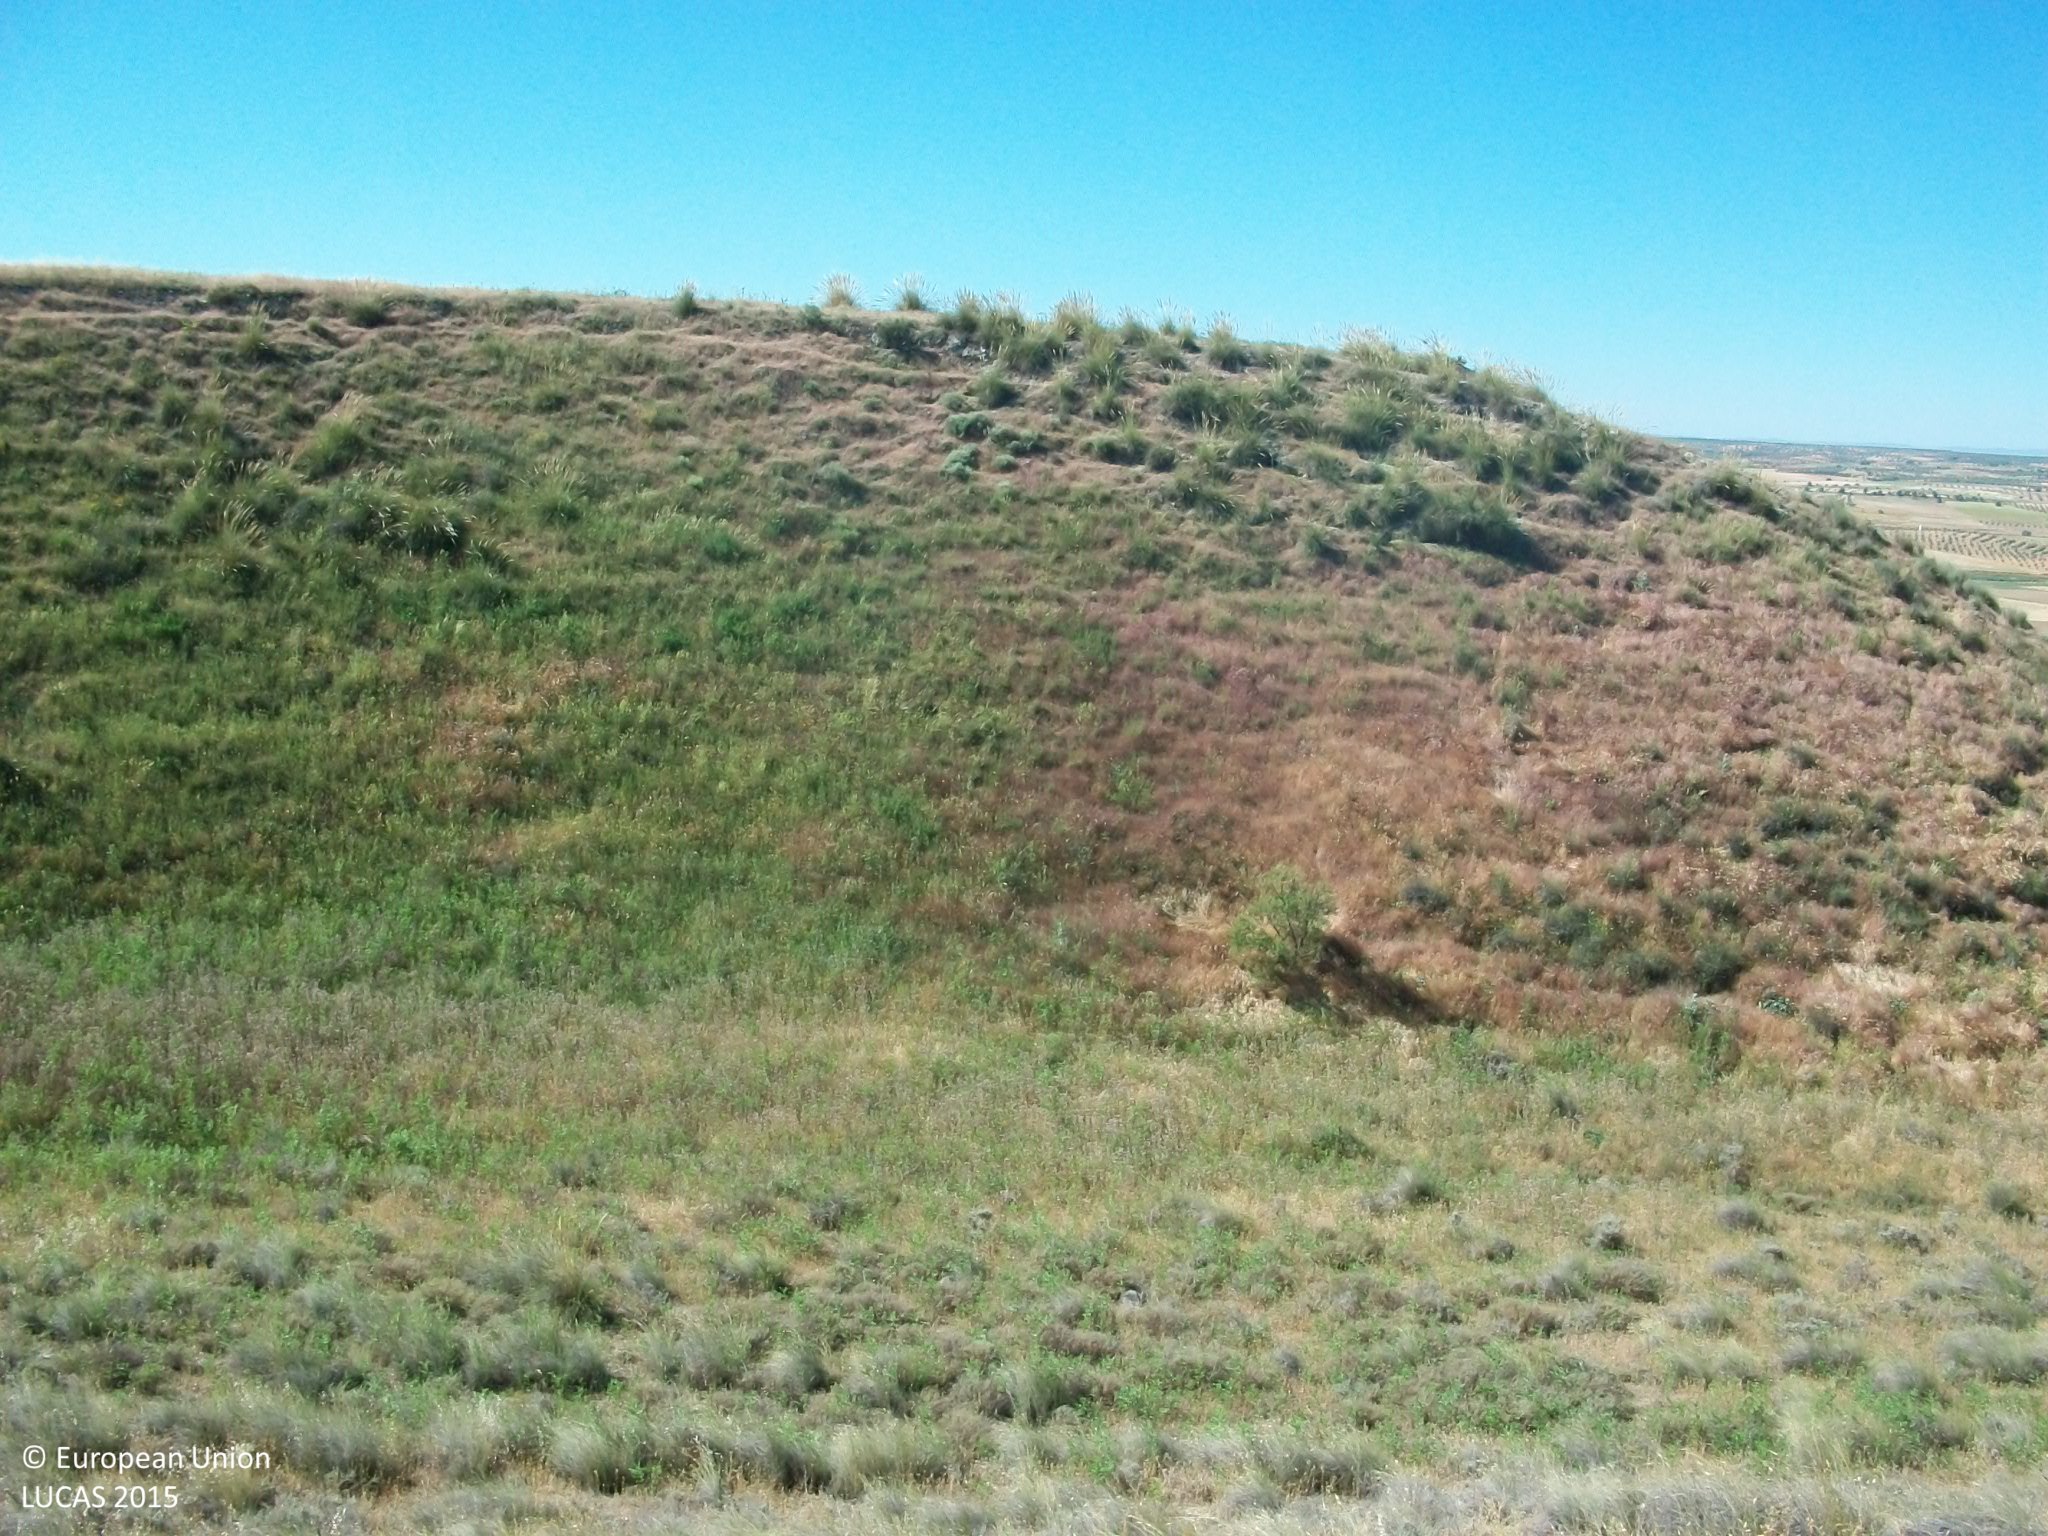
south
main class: Grassland
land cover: Grassland without tree/shrub cover
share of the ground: > 75 %
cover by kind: herbaceous plants 80 %, consolidated bare surface 20 %
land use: Semi-natural and natural areas not in use
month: May
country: ES
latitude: 39.8729
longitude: -3.6741
